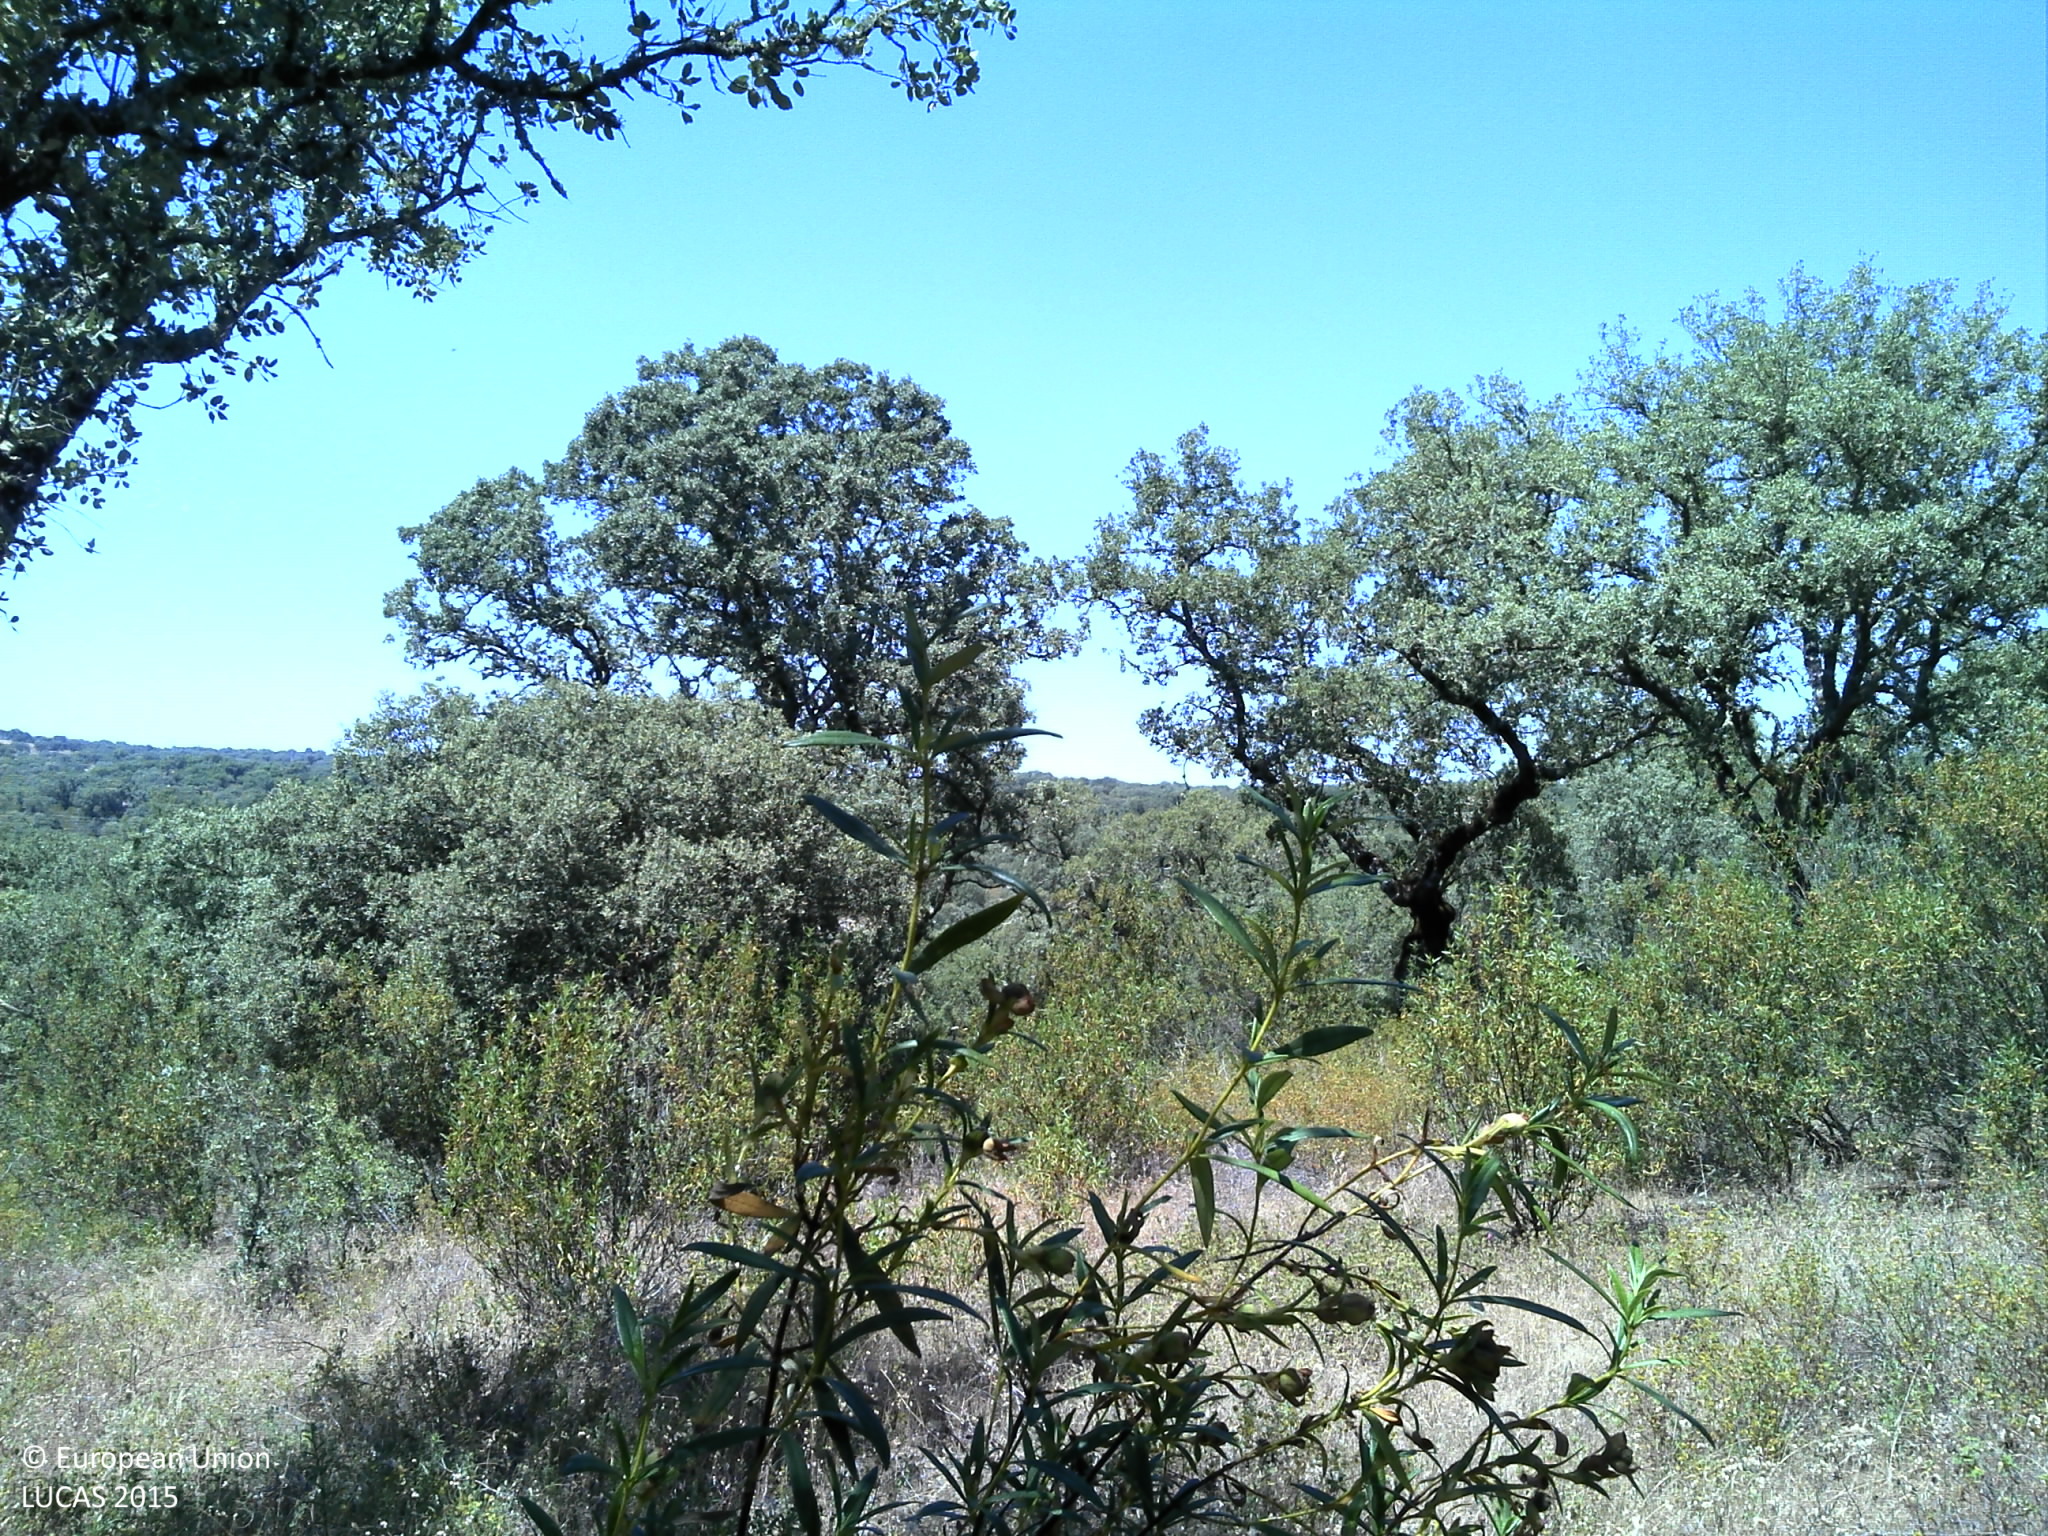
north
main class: Woodland
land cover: Broadleaved woodland
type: broadleaved evergreen forest
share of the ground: > 75 %
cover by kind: broadleaved forest trees 75 %, shrubs 20 %, herbaceous plants 5 %
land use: Forestry
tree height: > 5 m
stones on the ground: < 10 %
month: May
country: PT
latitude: 38.7700
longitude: -8.1066
